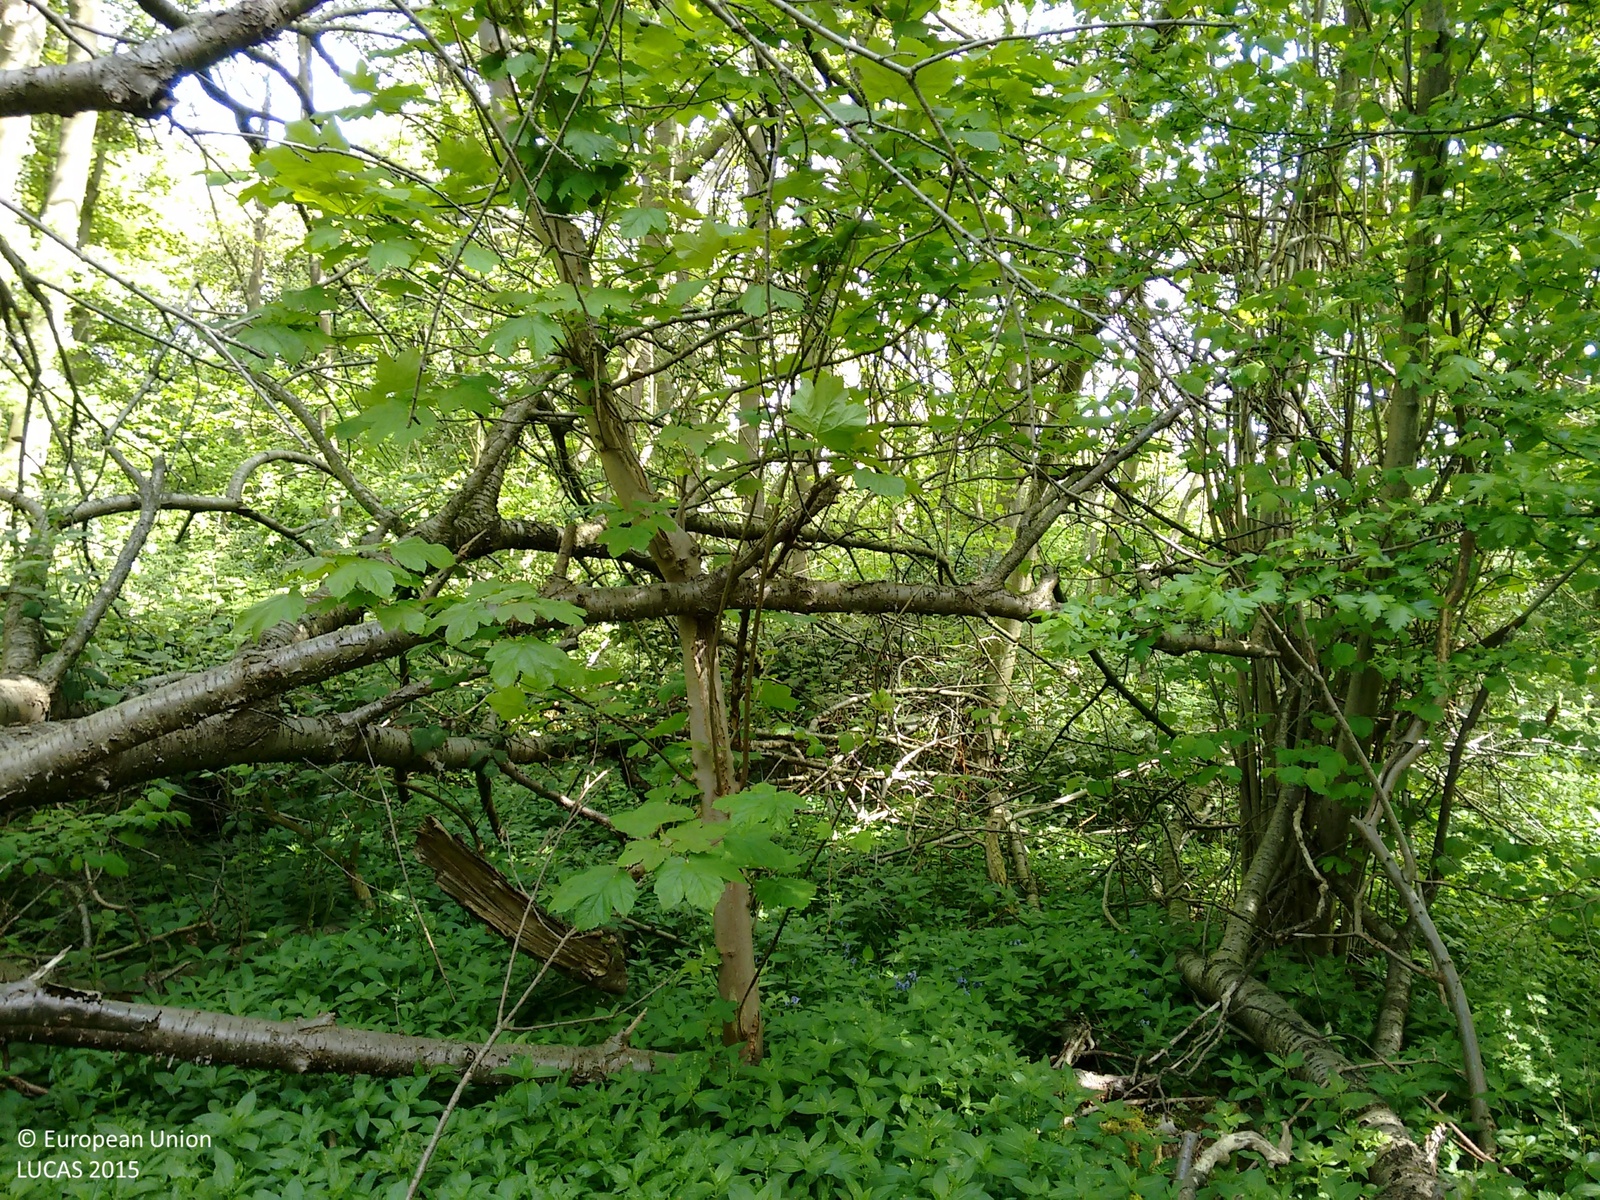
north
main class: Woodland
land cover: Broadleaved woodland
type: mesophytic deciduous forest
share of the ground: > 75 %
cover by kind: broadleaved forest trees 75 %, herbaceous plants 25 %
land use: Semi-natural and natural areas not in use
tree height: > 5 m
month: May
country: GB
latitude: 51.8429
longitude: -0.4449
